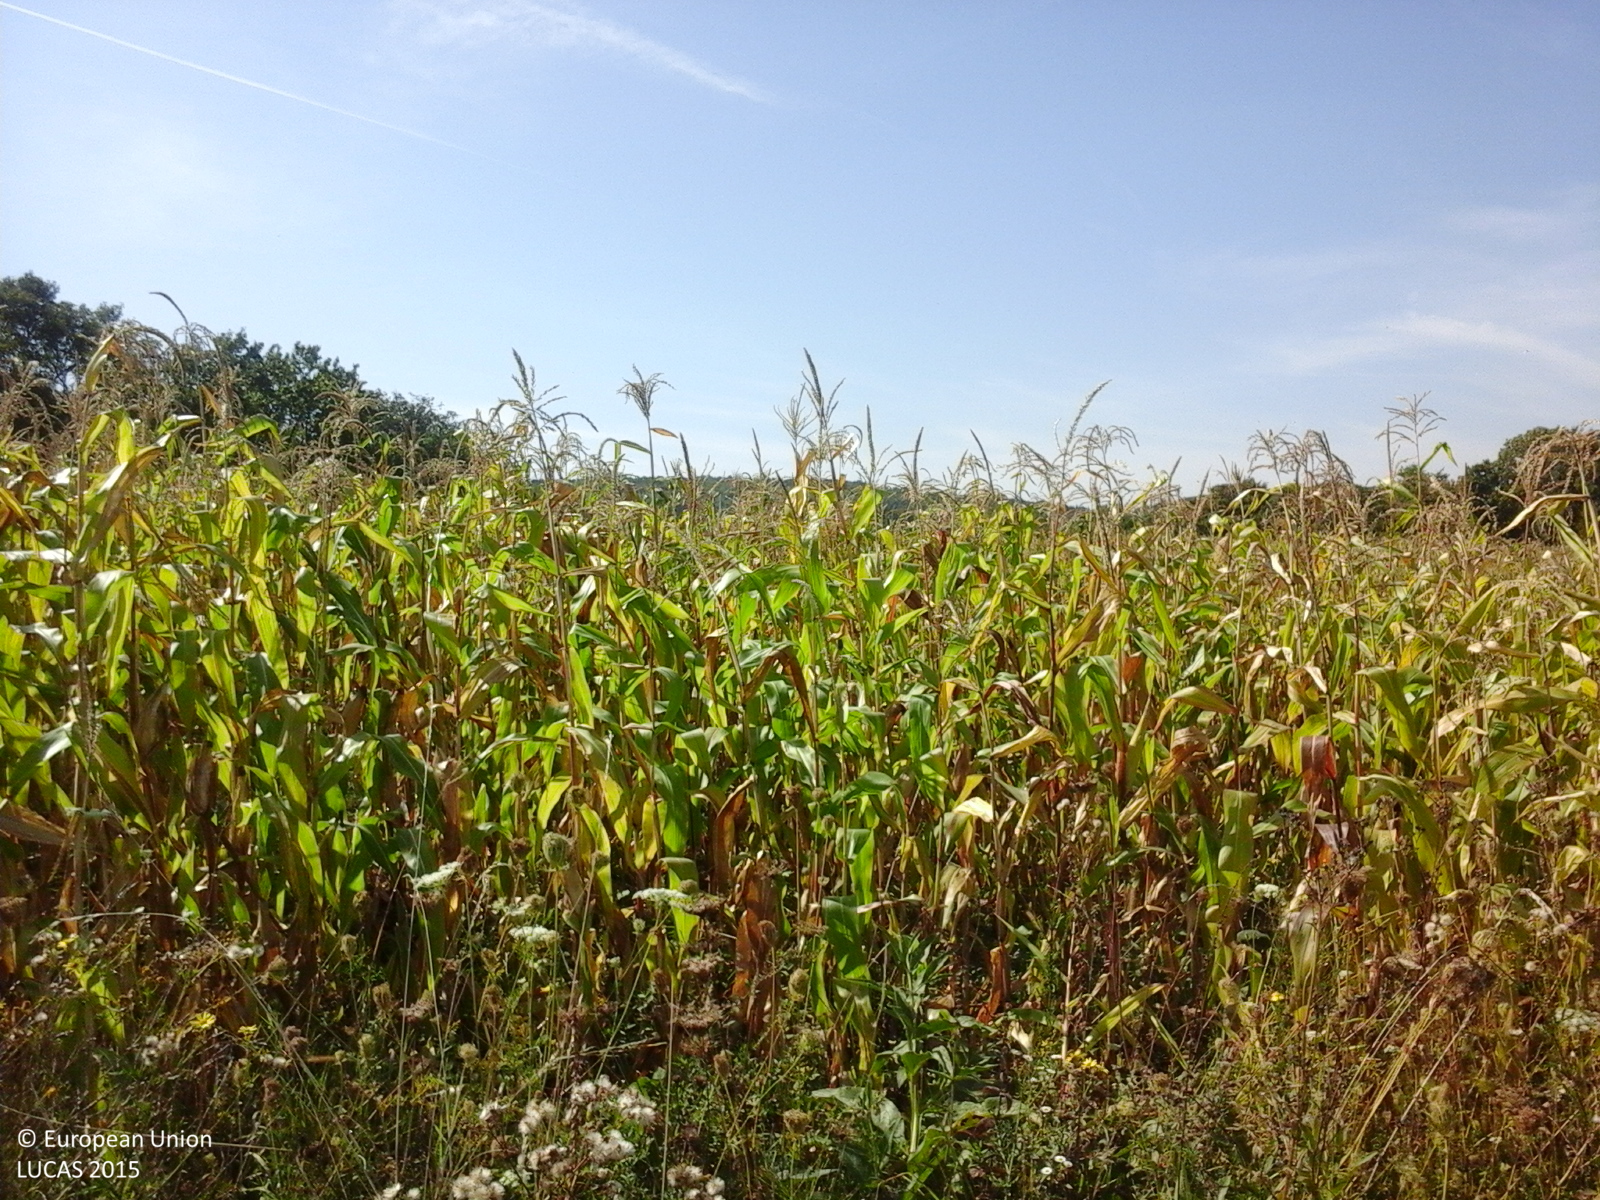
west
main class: Cropland
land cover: Maize
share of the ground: > 75 %
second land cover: Spontaneously vegetated surfaces
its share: 25 - 50 %
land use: Agriculture (excluding fallow land and kitchen gardens)
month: September
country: RO
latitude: 46.8653
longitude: 23.5967
